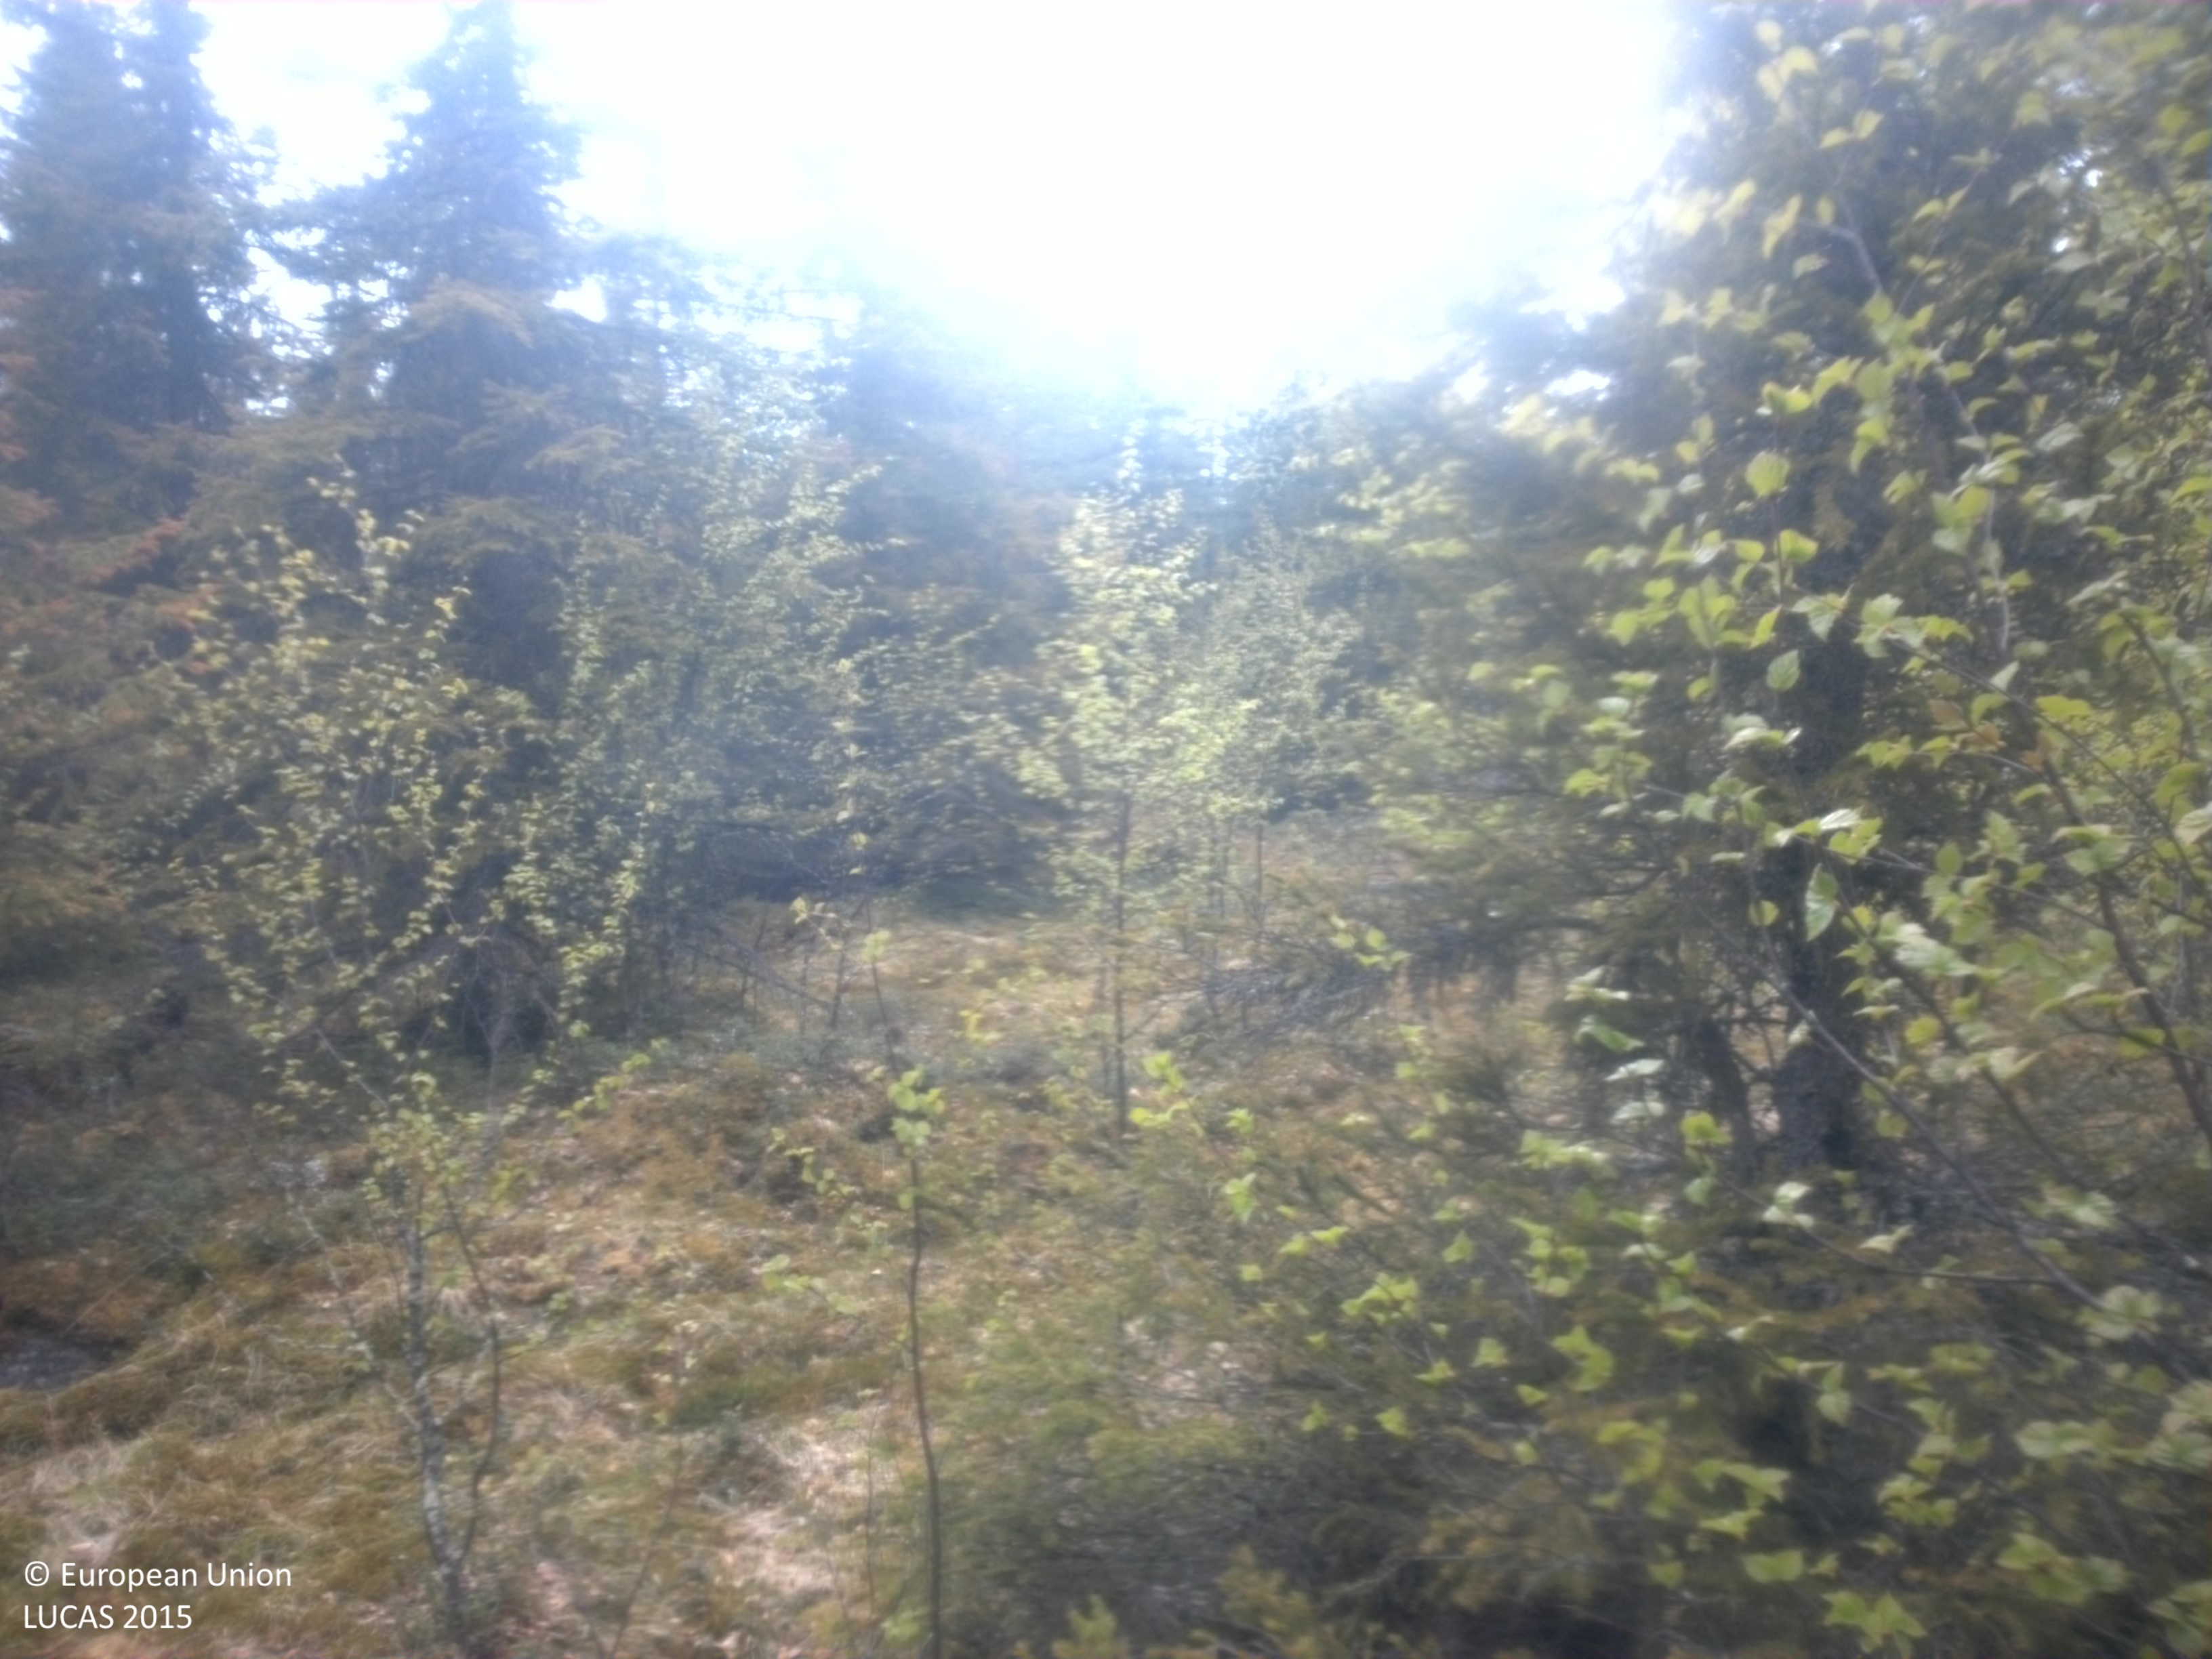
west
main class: Woodland
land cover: Broadleaved woodland
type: boreal forest
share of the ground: 25 - 50 %
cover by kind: broadleaved forest trees 35 %, herbaceous plants 35 %, lichens and mosses 15 %, unconsolidated bare surface 10 %, coniferous forest trees 5 %
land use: Forestry
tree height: < 5 m
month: June
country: SE
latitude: 64.3906
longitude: 17.7440
